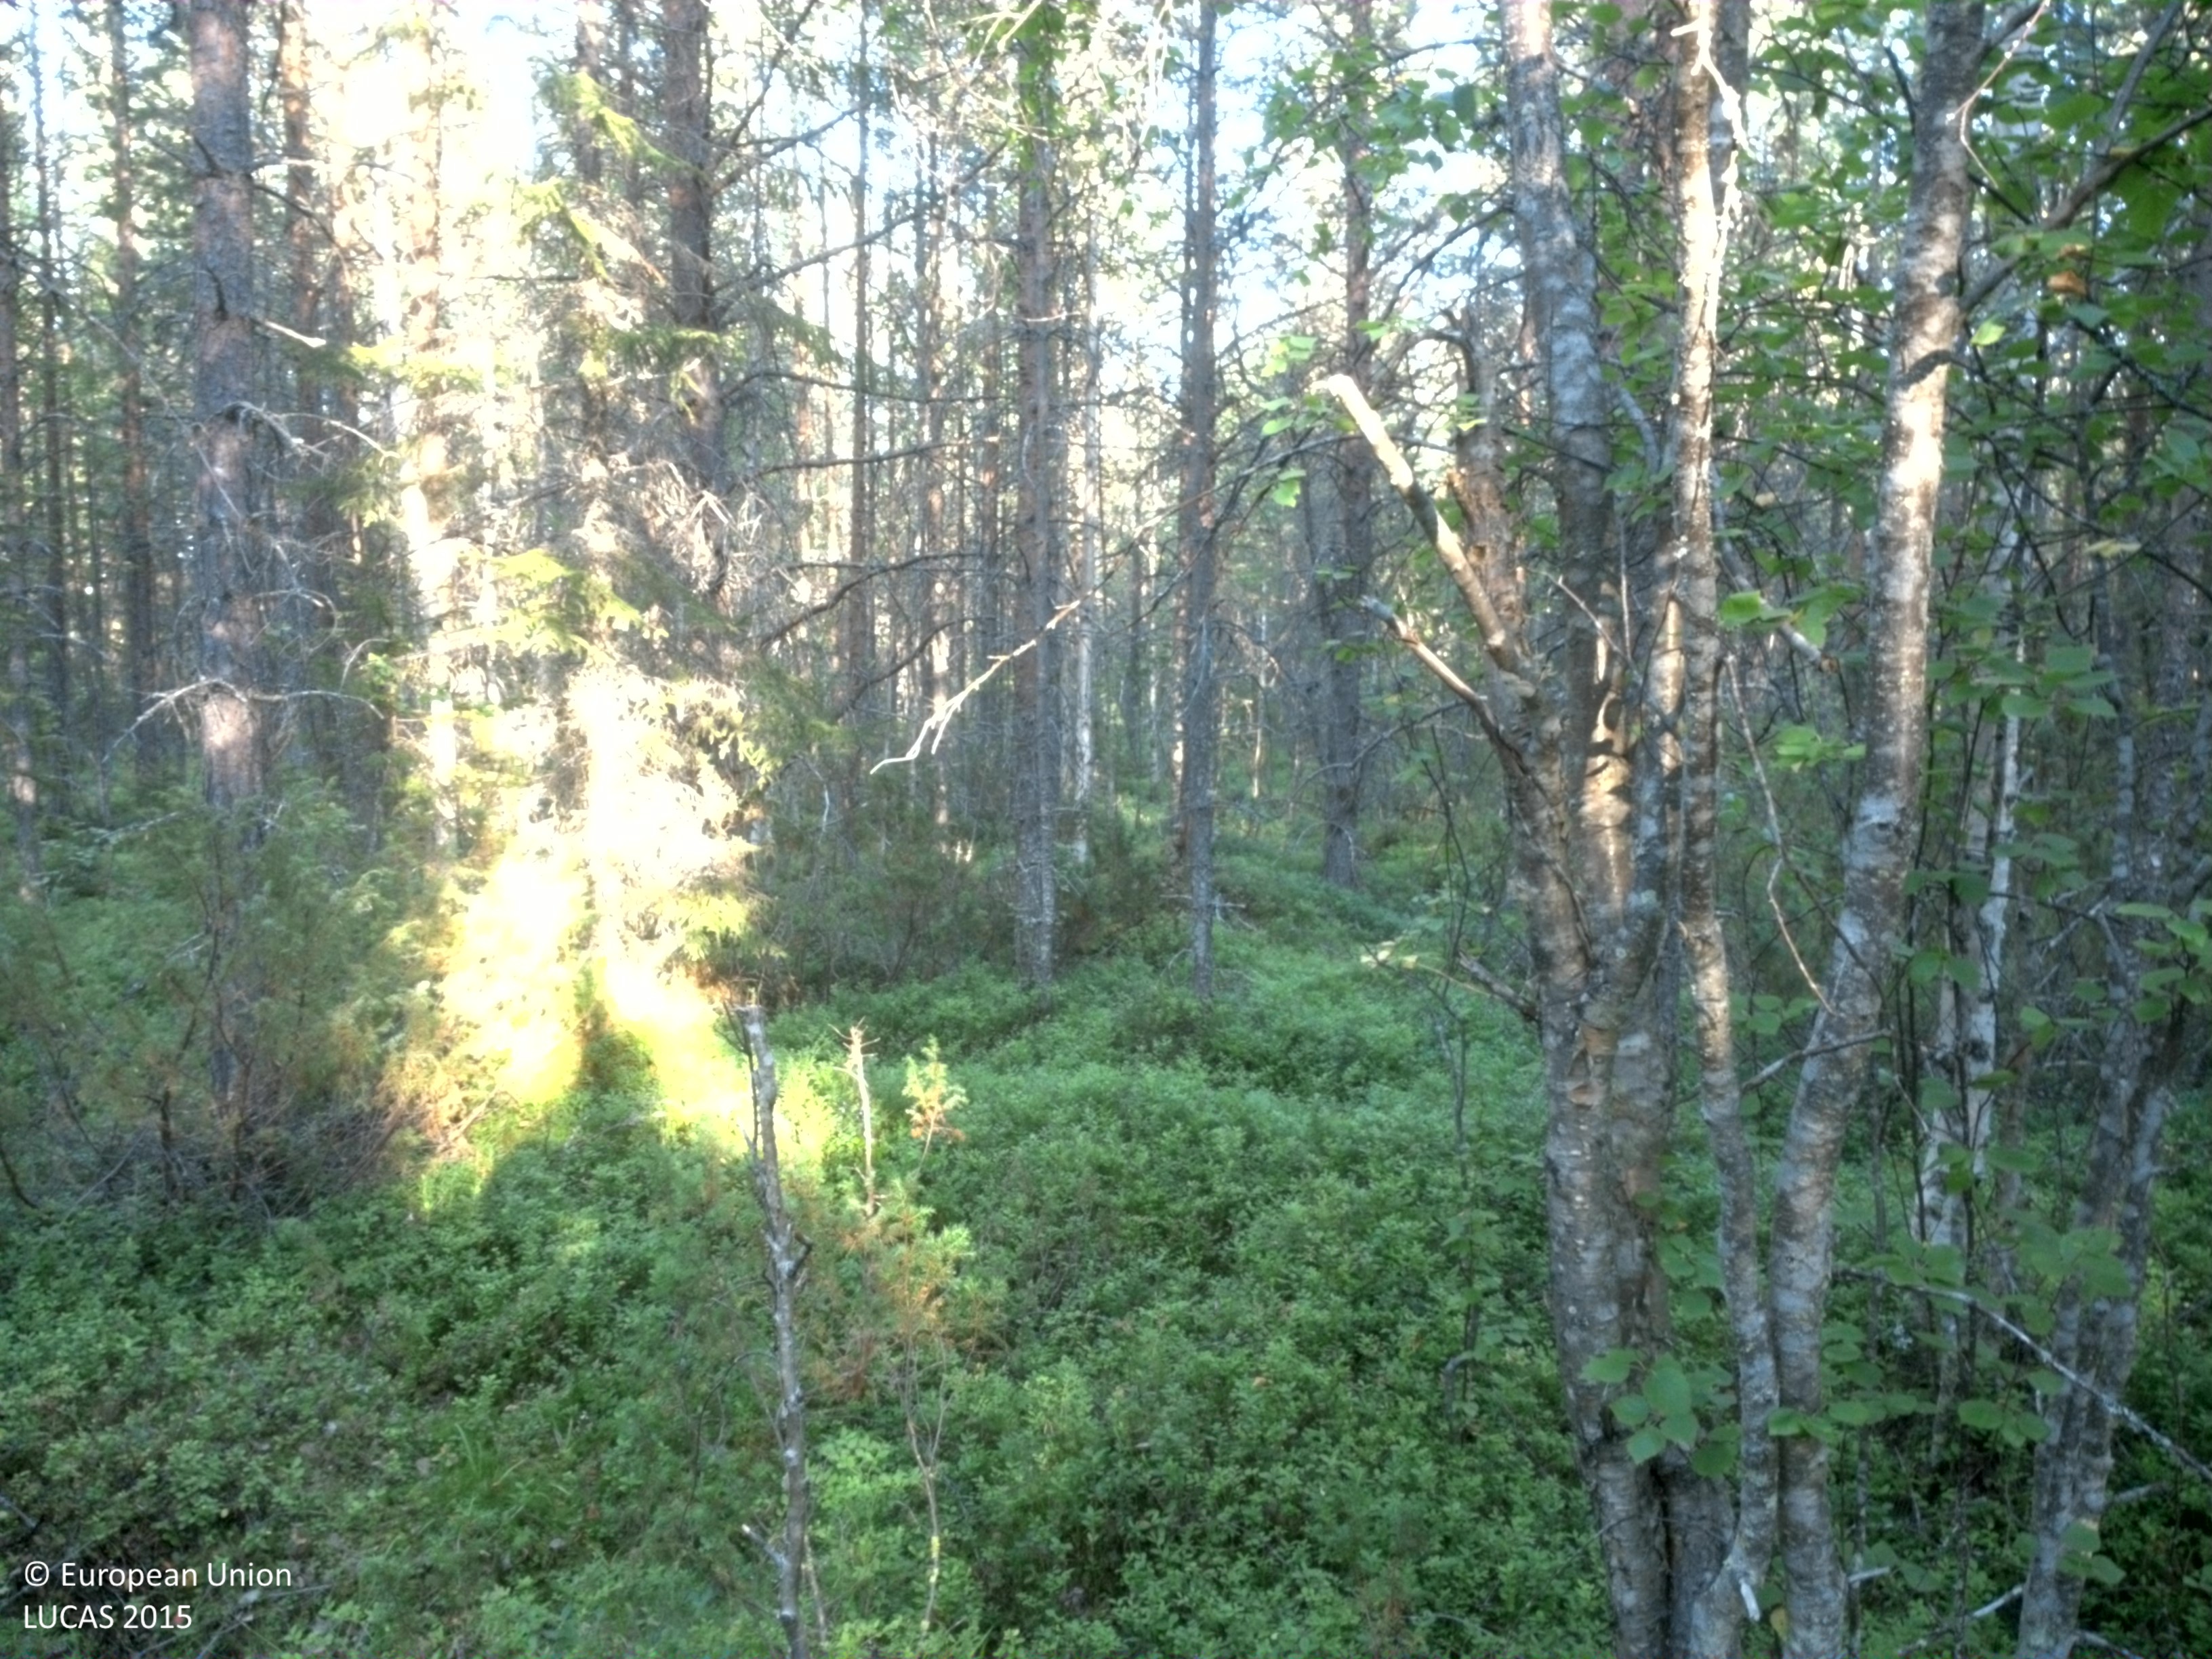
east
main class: Woodland
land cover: Pine dominated mixed woodland
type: boreal forest
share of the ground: 50 - 75 %
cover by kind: coniferous forest trees 45 %, shrubs 35 %, broadleaved forest trees 15 %, lichens and mosses 5 %
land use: Forestry
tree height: > 5 m
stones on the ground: 25 - 50 %
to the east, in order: Pine dominated mixed woodland; Other mixed woodland
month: August
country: SE
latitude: 64.6500
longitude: 19.0327
